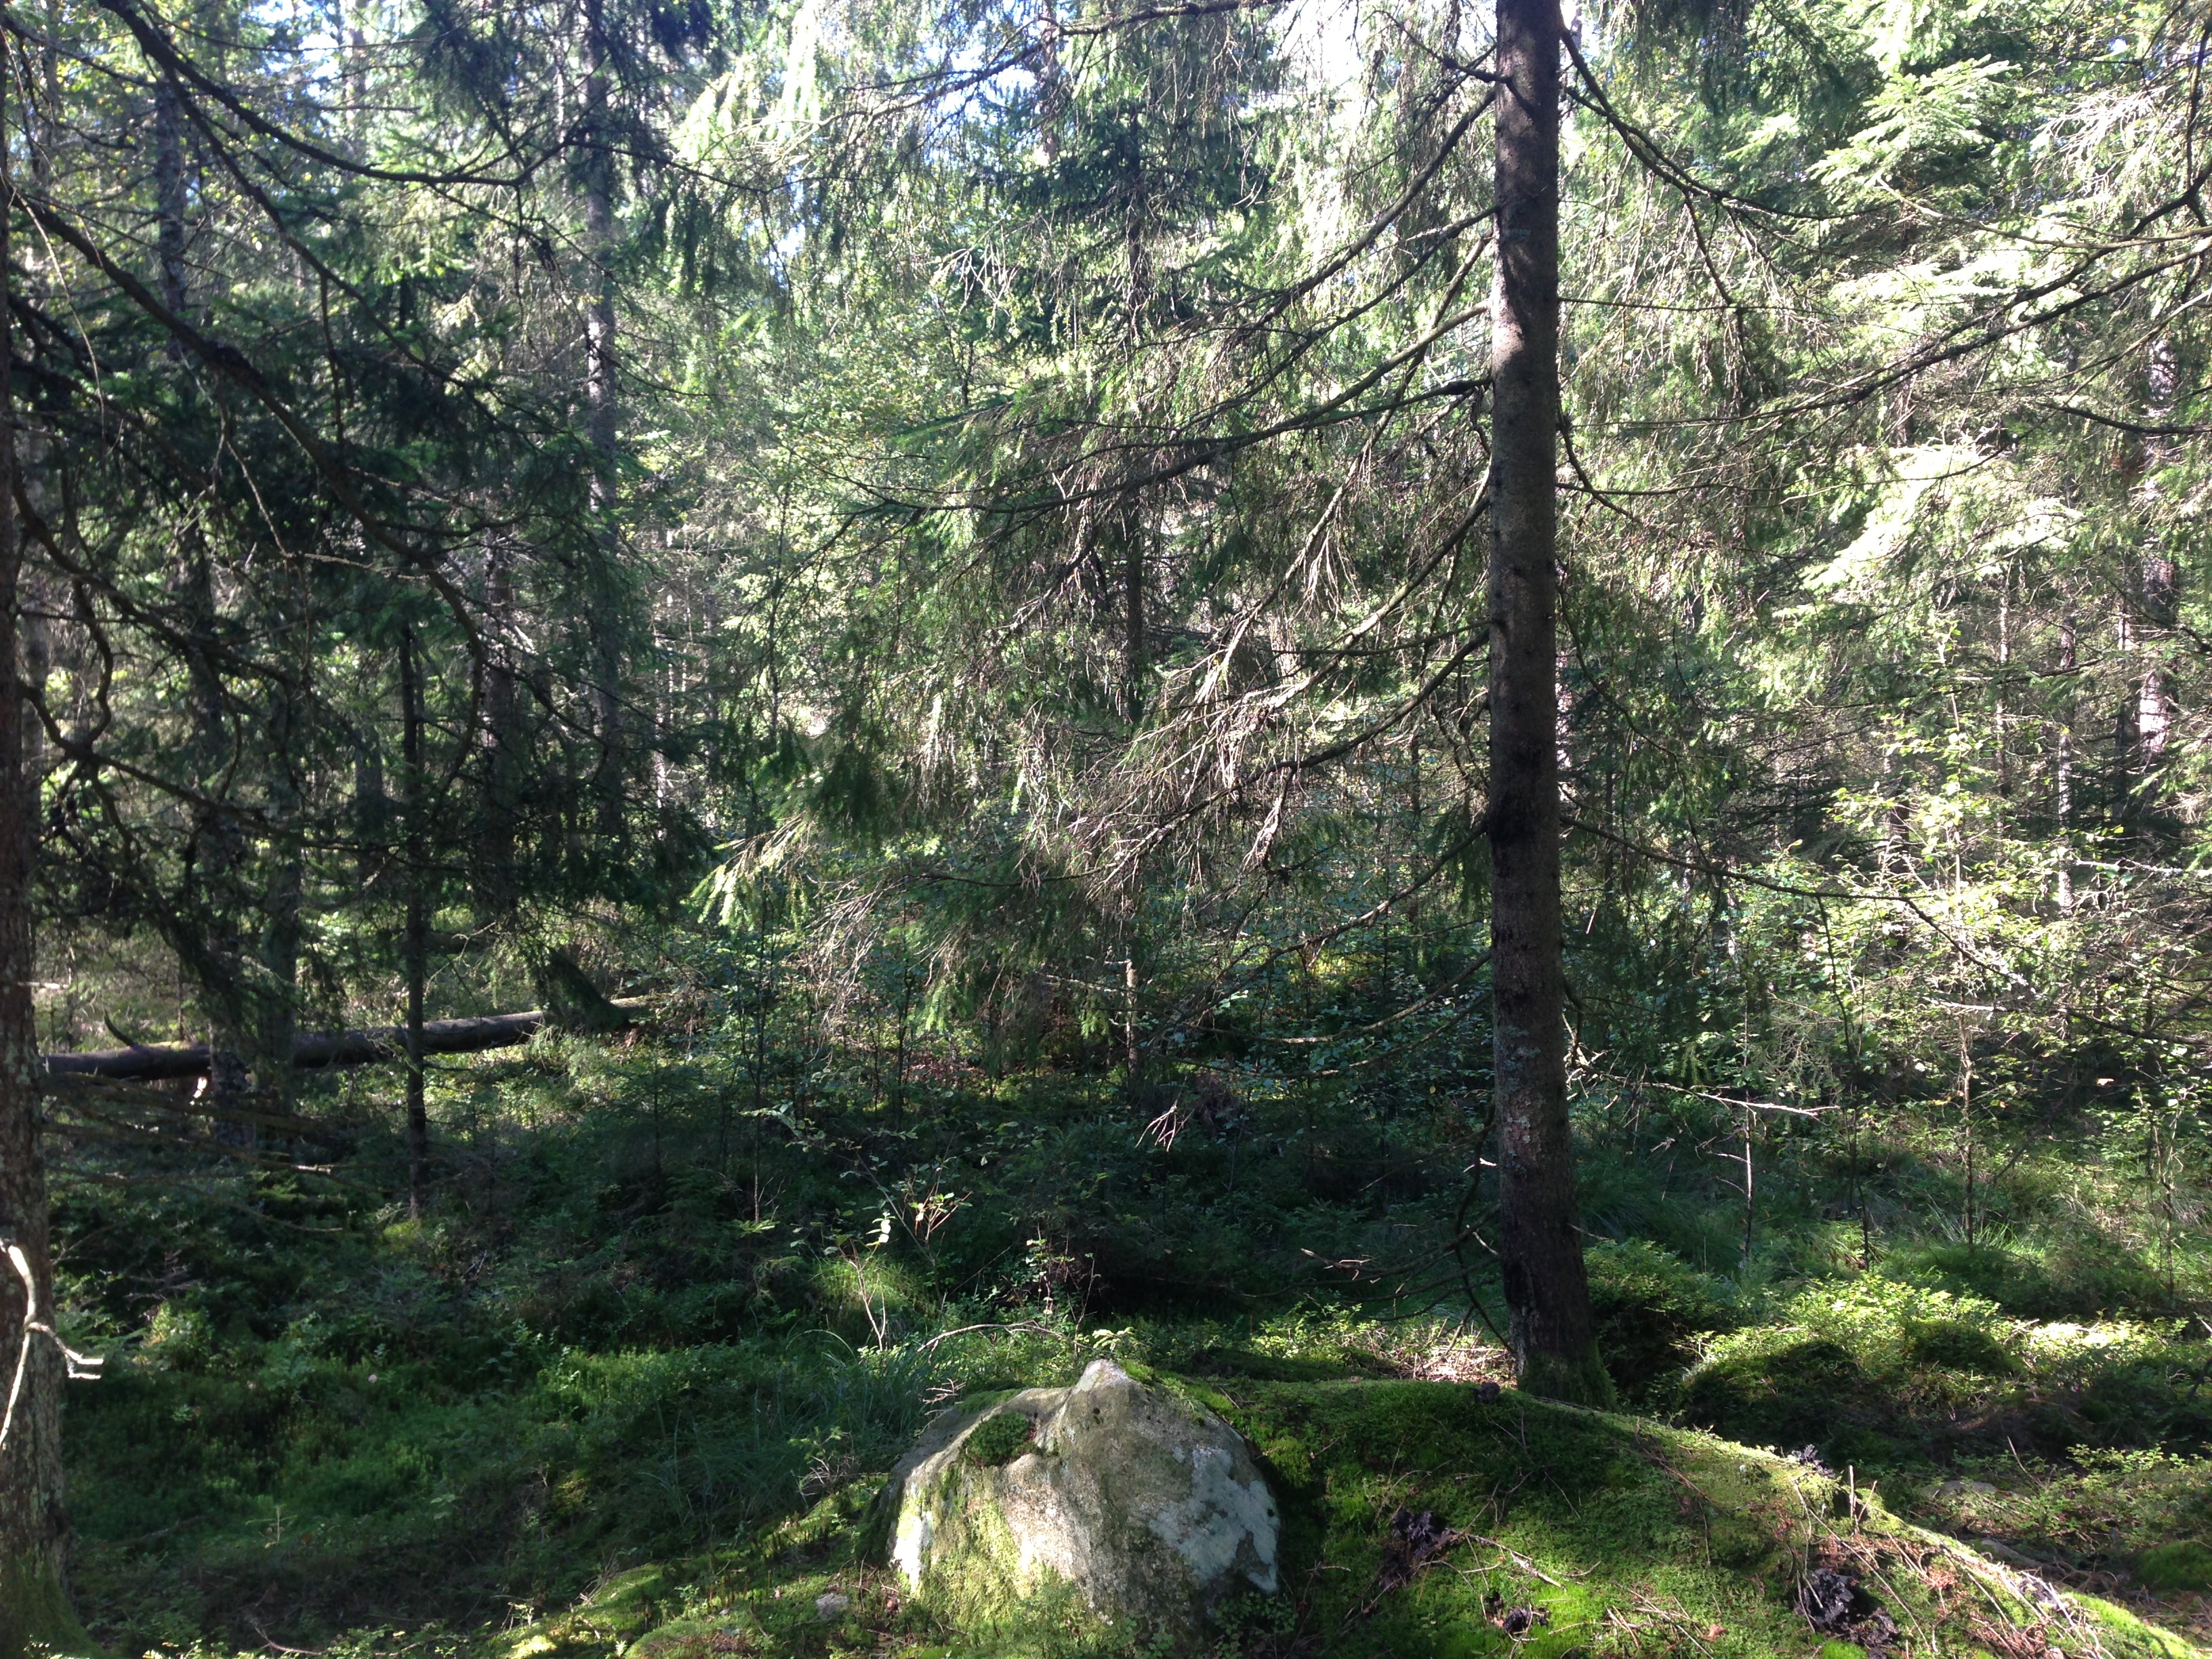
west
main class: Woodland
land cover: Spruce dominated coniferous woodland
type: boreal forest
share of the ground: > 75 %
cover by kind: coniferous forest trees 80 %, shrubs 20 %
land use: Forestry
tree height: > 5 m
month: September
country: SE
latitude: 57.1910
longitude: 13.2229
